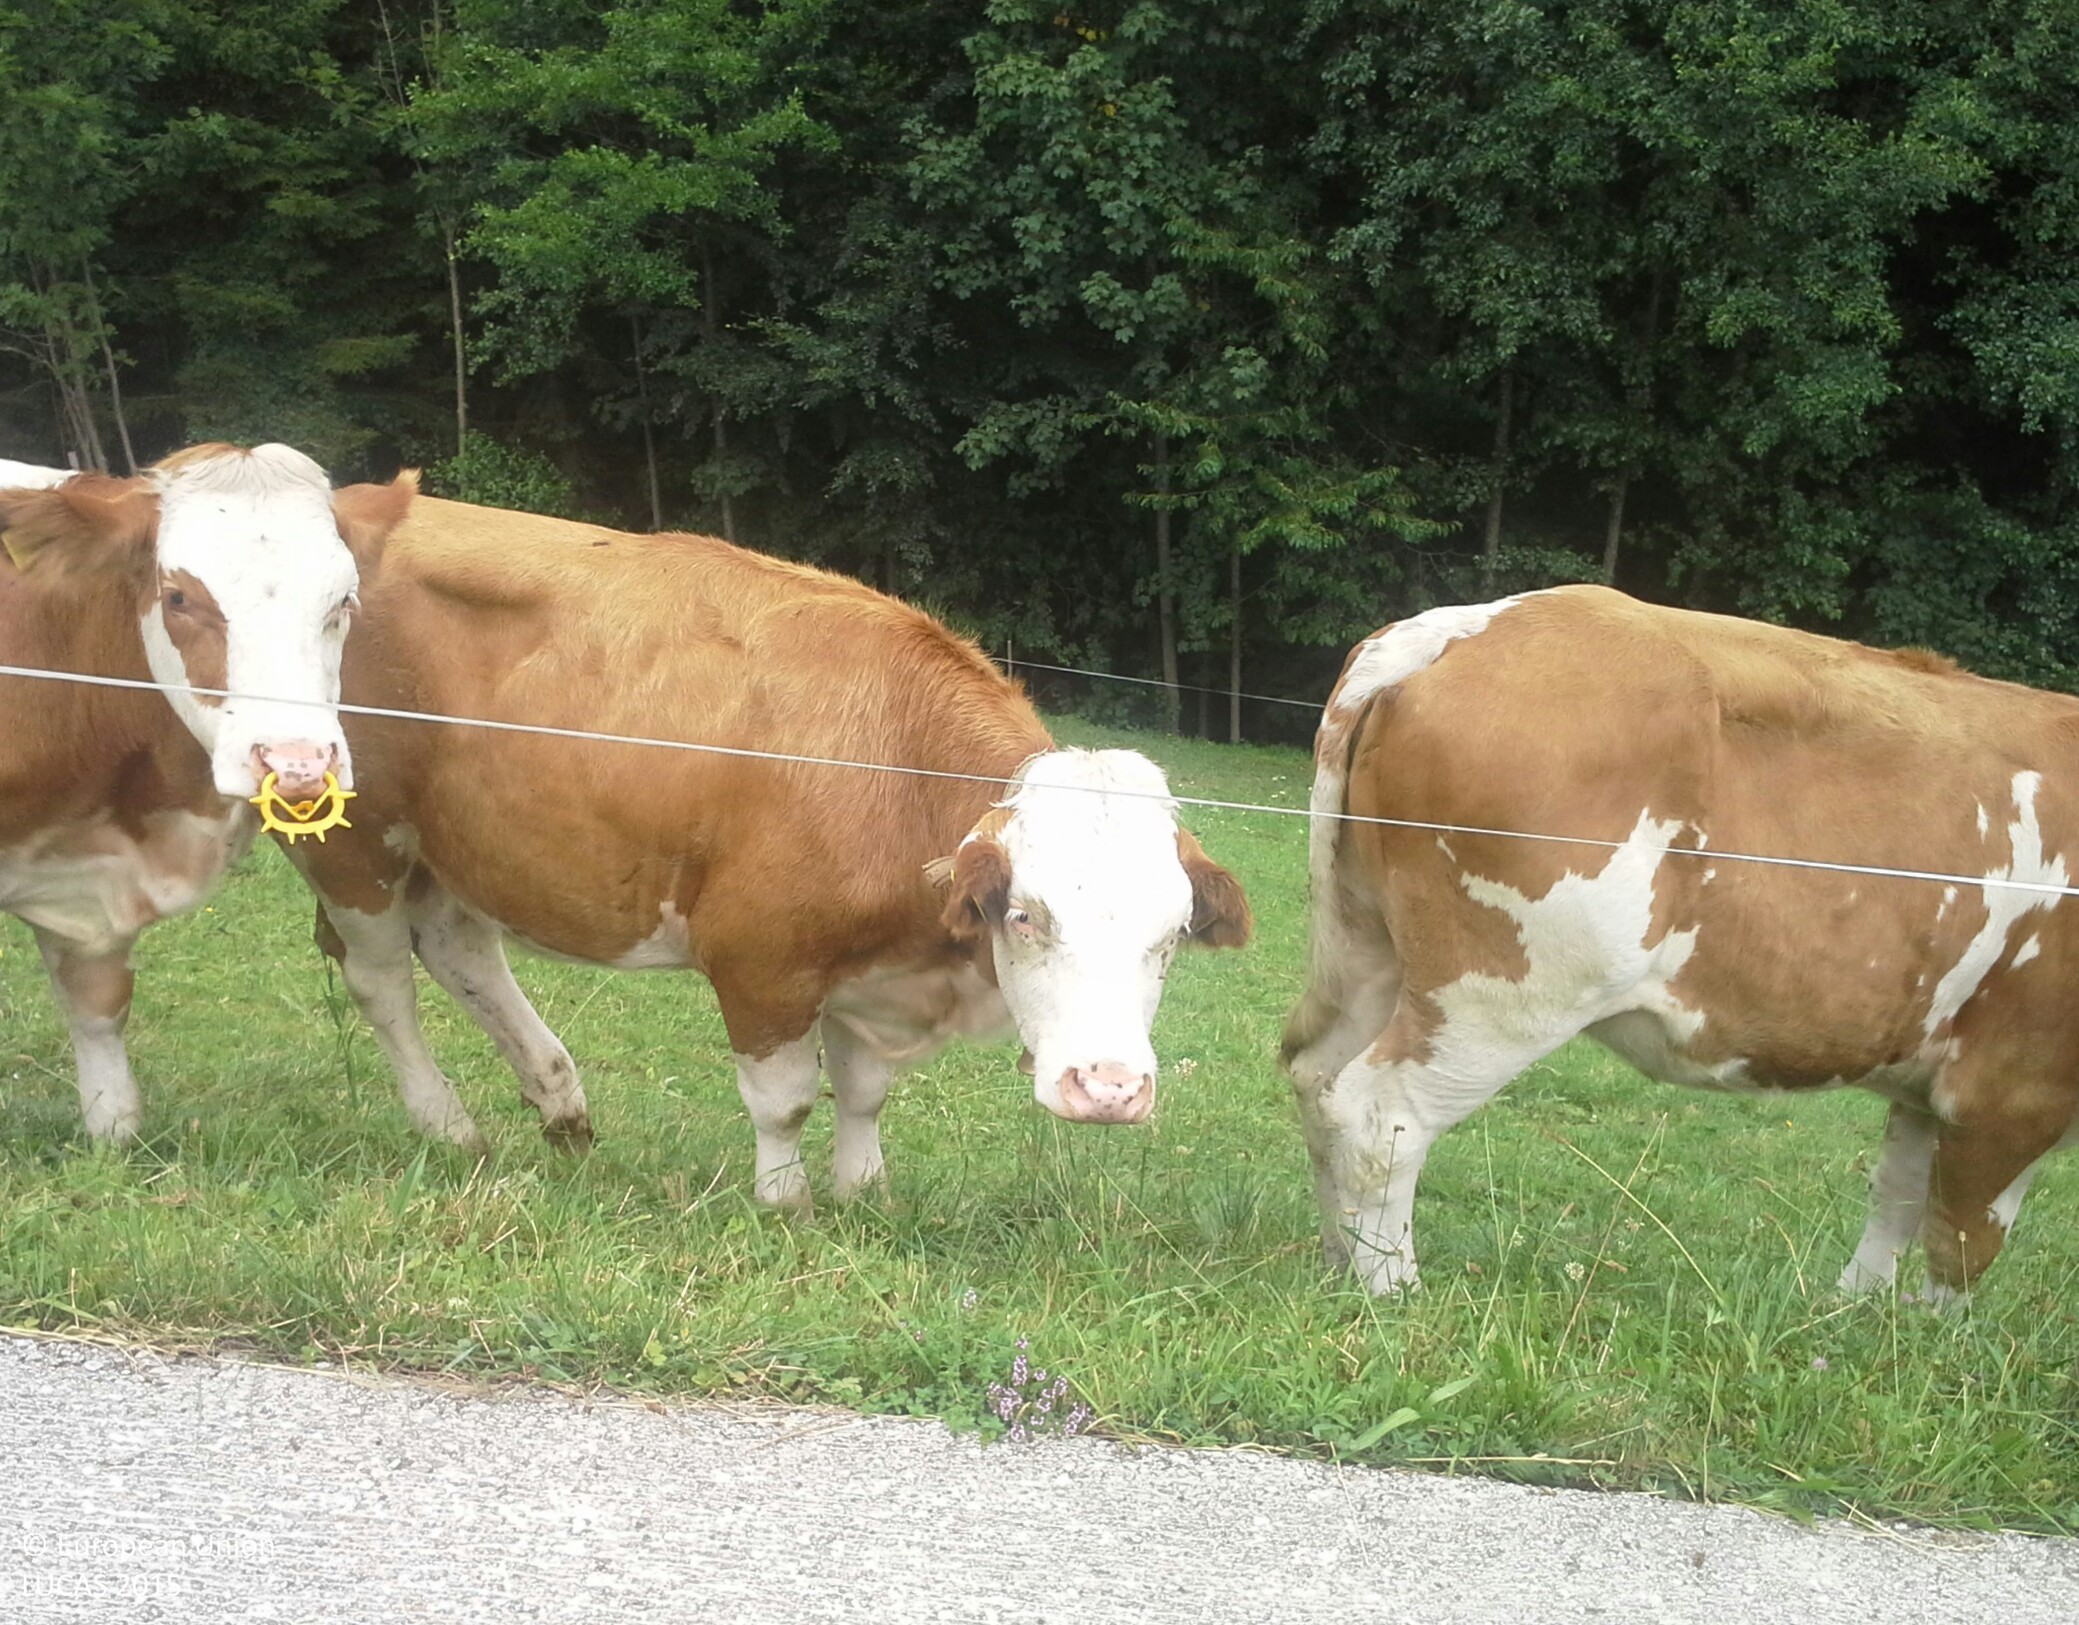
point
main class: Grassland
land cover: Grassland without tree/shrub cover
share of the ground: > 75 %
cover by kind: herbaceous plants 100 %
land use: Agriculture (excluding fallow land and kitchen gardens)
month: July
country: AT
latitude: 48.0187
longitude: 15.0287
